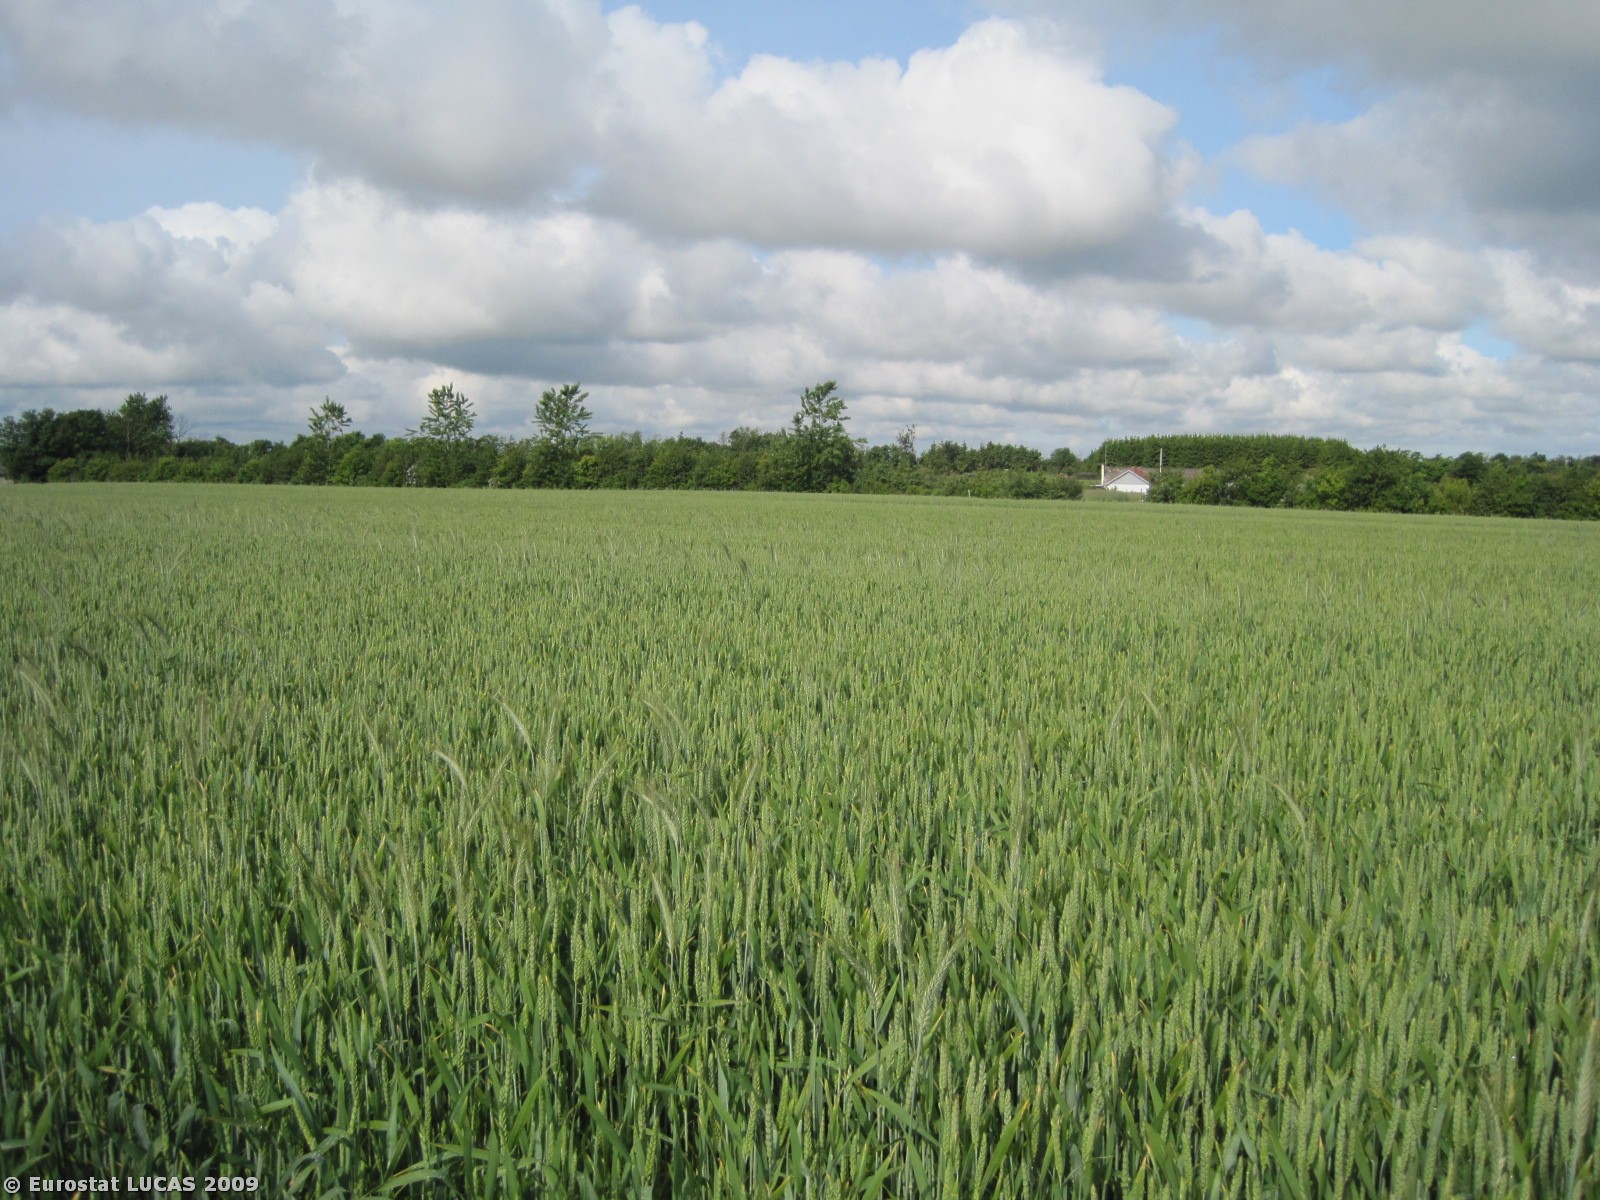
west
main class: Cropland
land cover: Common wheat
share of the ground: > 75 %
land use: Agriculture (excluding fallow land and kitchen gardens)
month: June
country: DK
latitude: 57.3203
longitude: 10.0497
